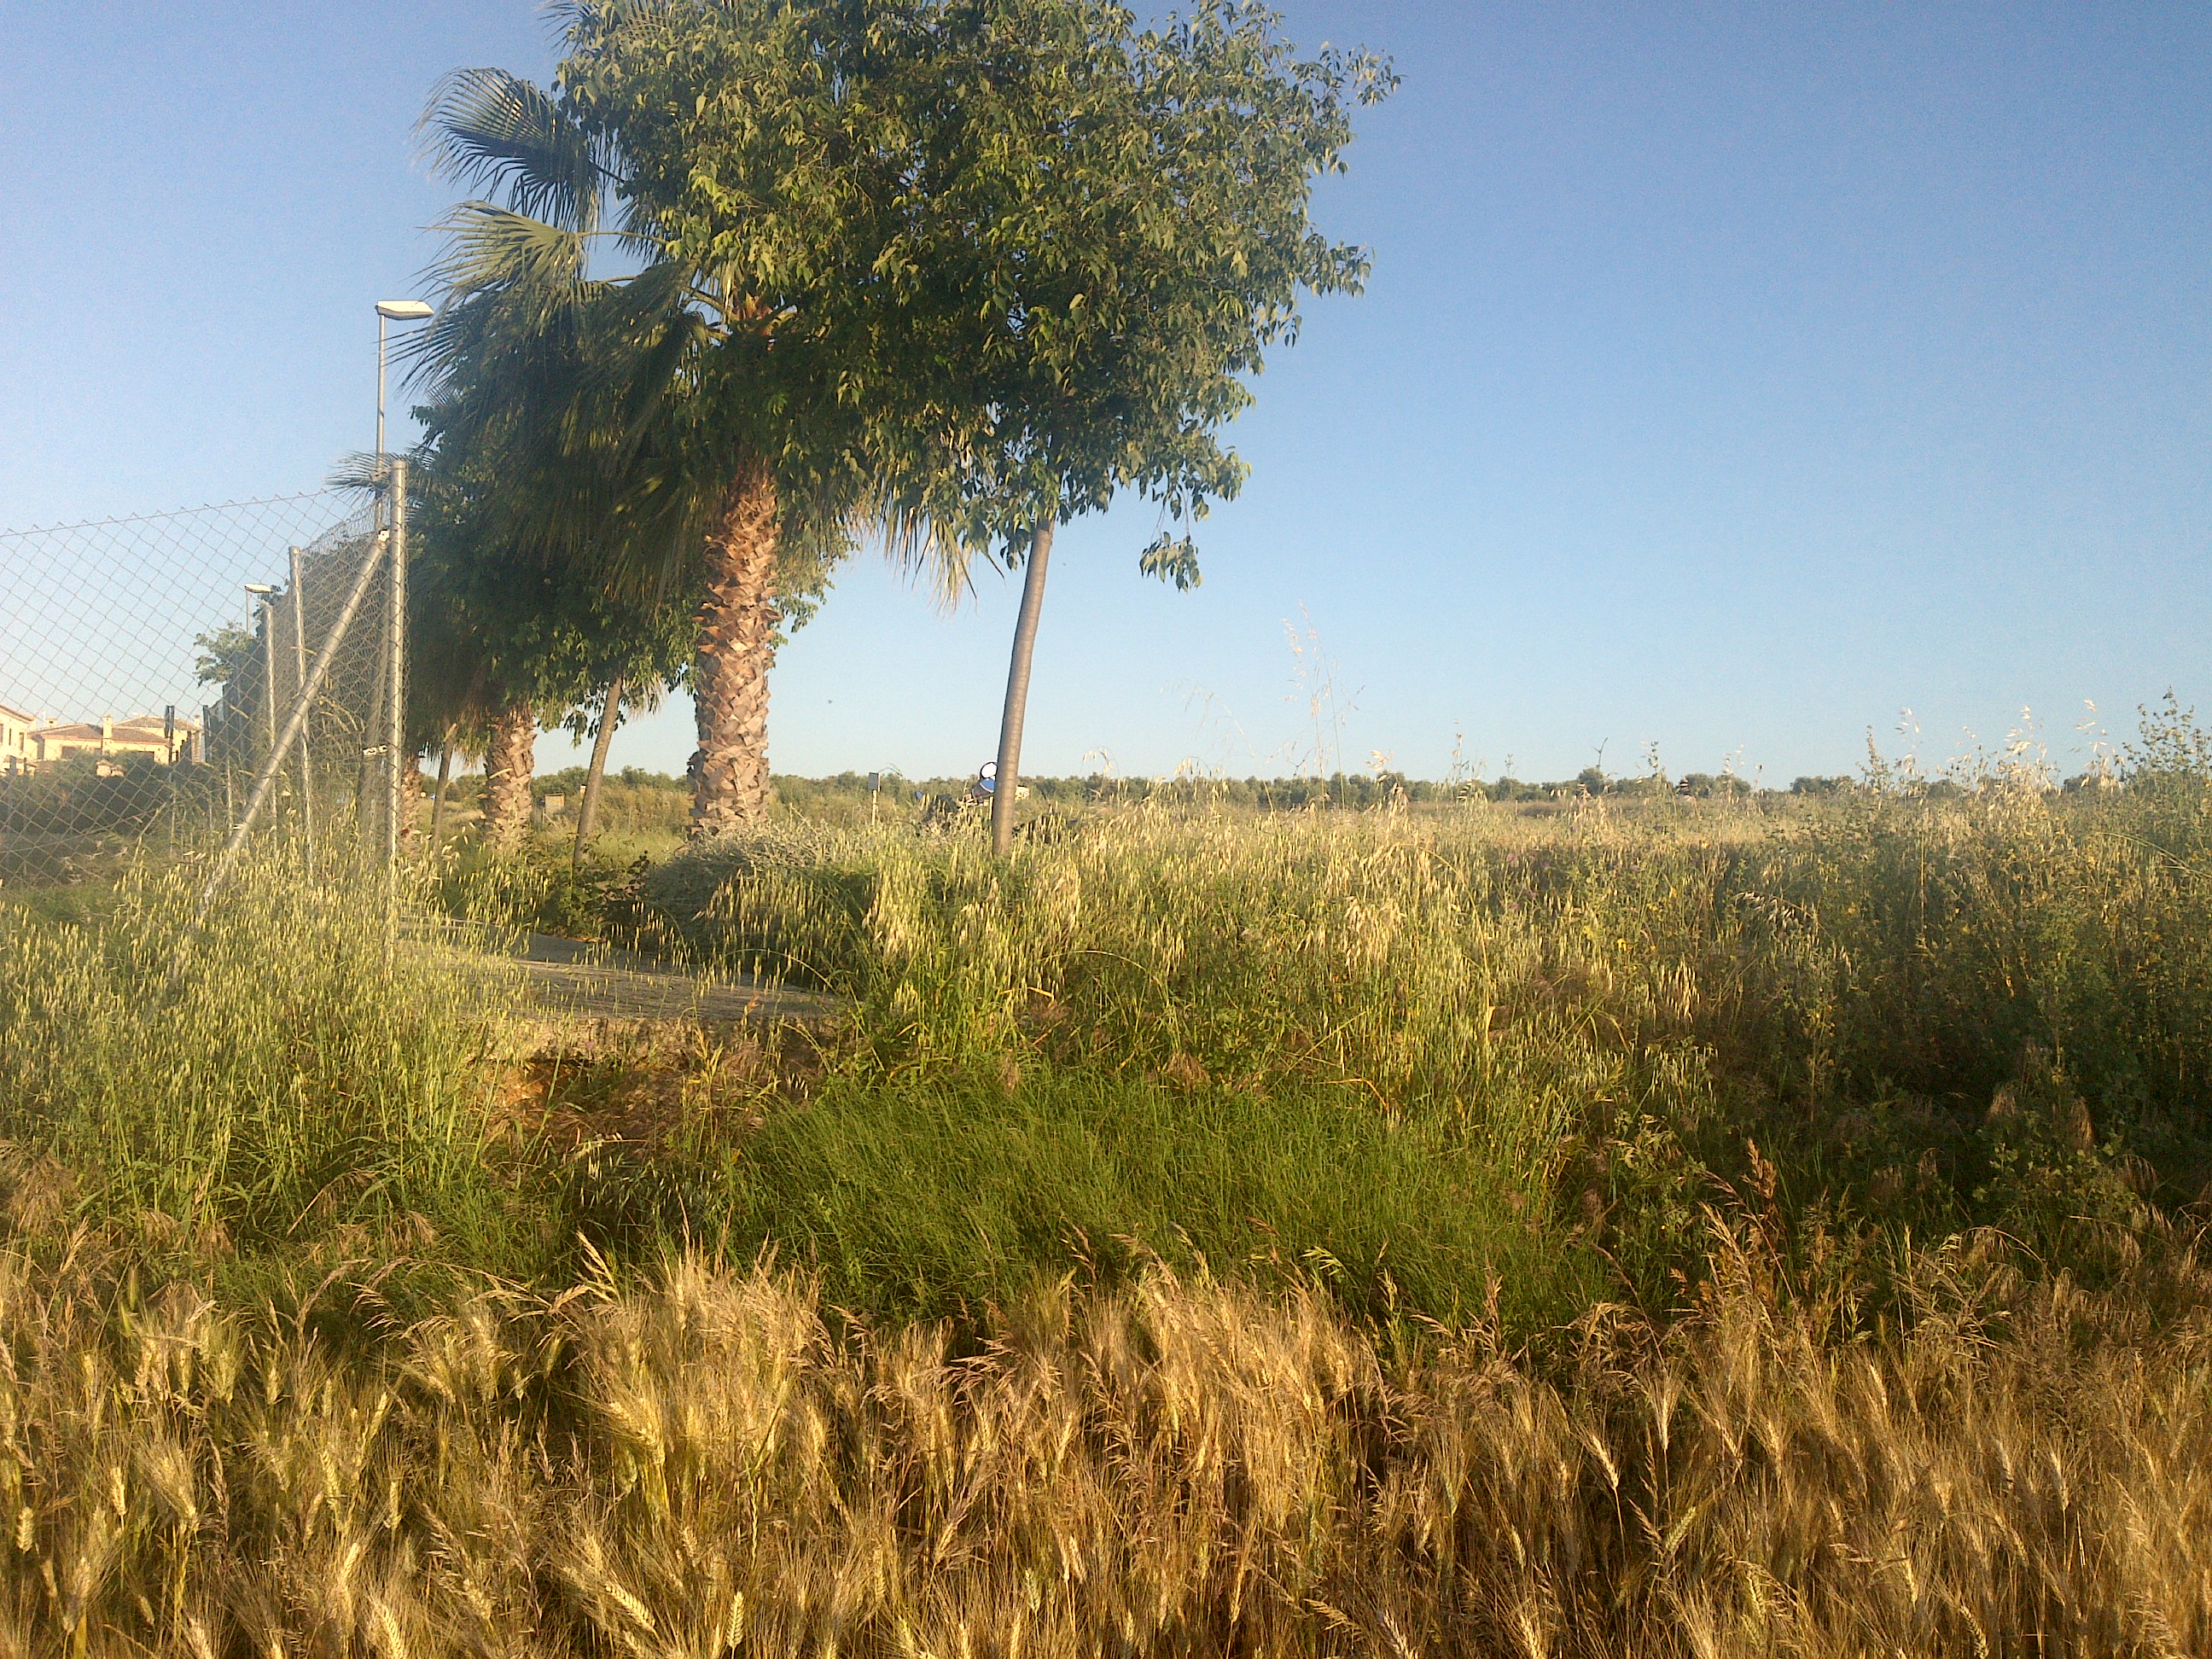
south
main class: Cropland
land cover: Durum wheat
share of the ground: > 75 %
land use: Agriculture (excluding fallow land and kitchen gardens)
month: May
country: ES
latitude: 37.6815
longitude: -4.9467
